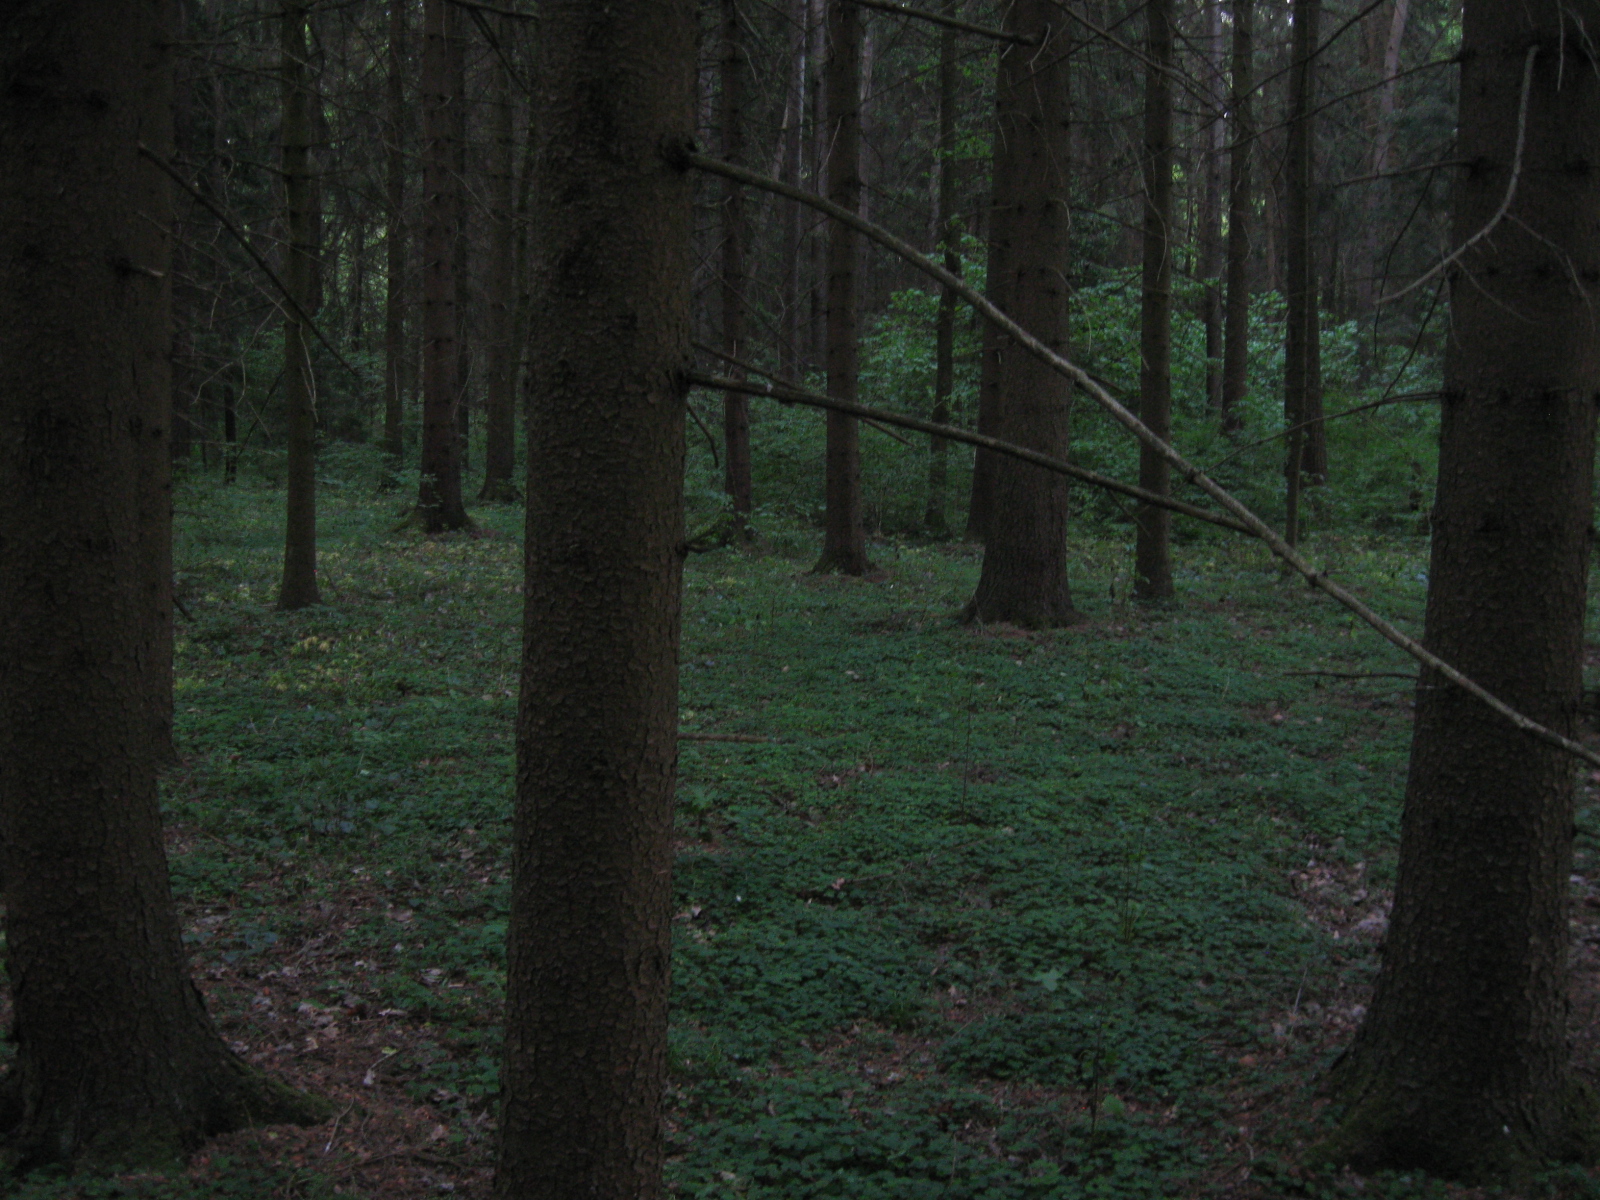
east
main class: Woodland
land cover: Spruce dominated coniferous woodland
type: hemiboreal forest and nemoral coniferous forest and mixed broadleaved-coniferous forest
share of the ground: > 75 %
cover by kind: coniferous forest trees 85 %, broadleaved forest trees 15 %
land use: Forestry
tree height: > 5 m
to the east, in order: Spruce dominated coniferous woodland; Spruce dominated mixed woodland
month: June
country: LT
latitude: 54.4617
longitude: 23.8656
